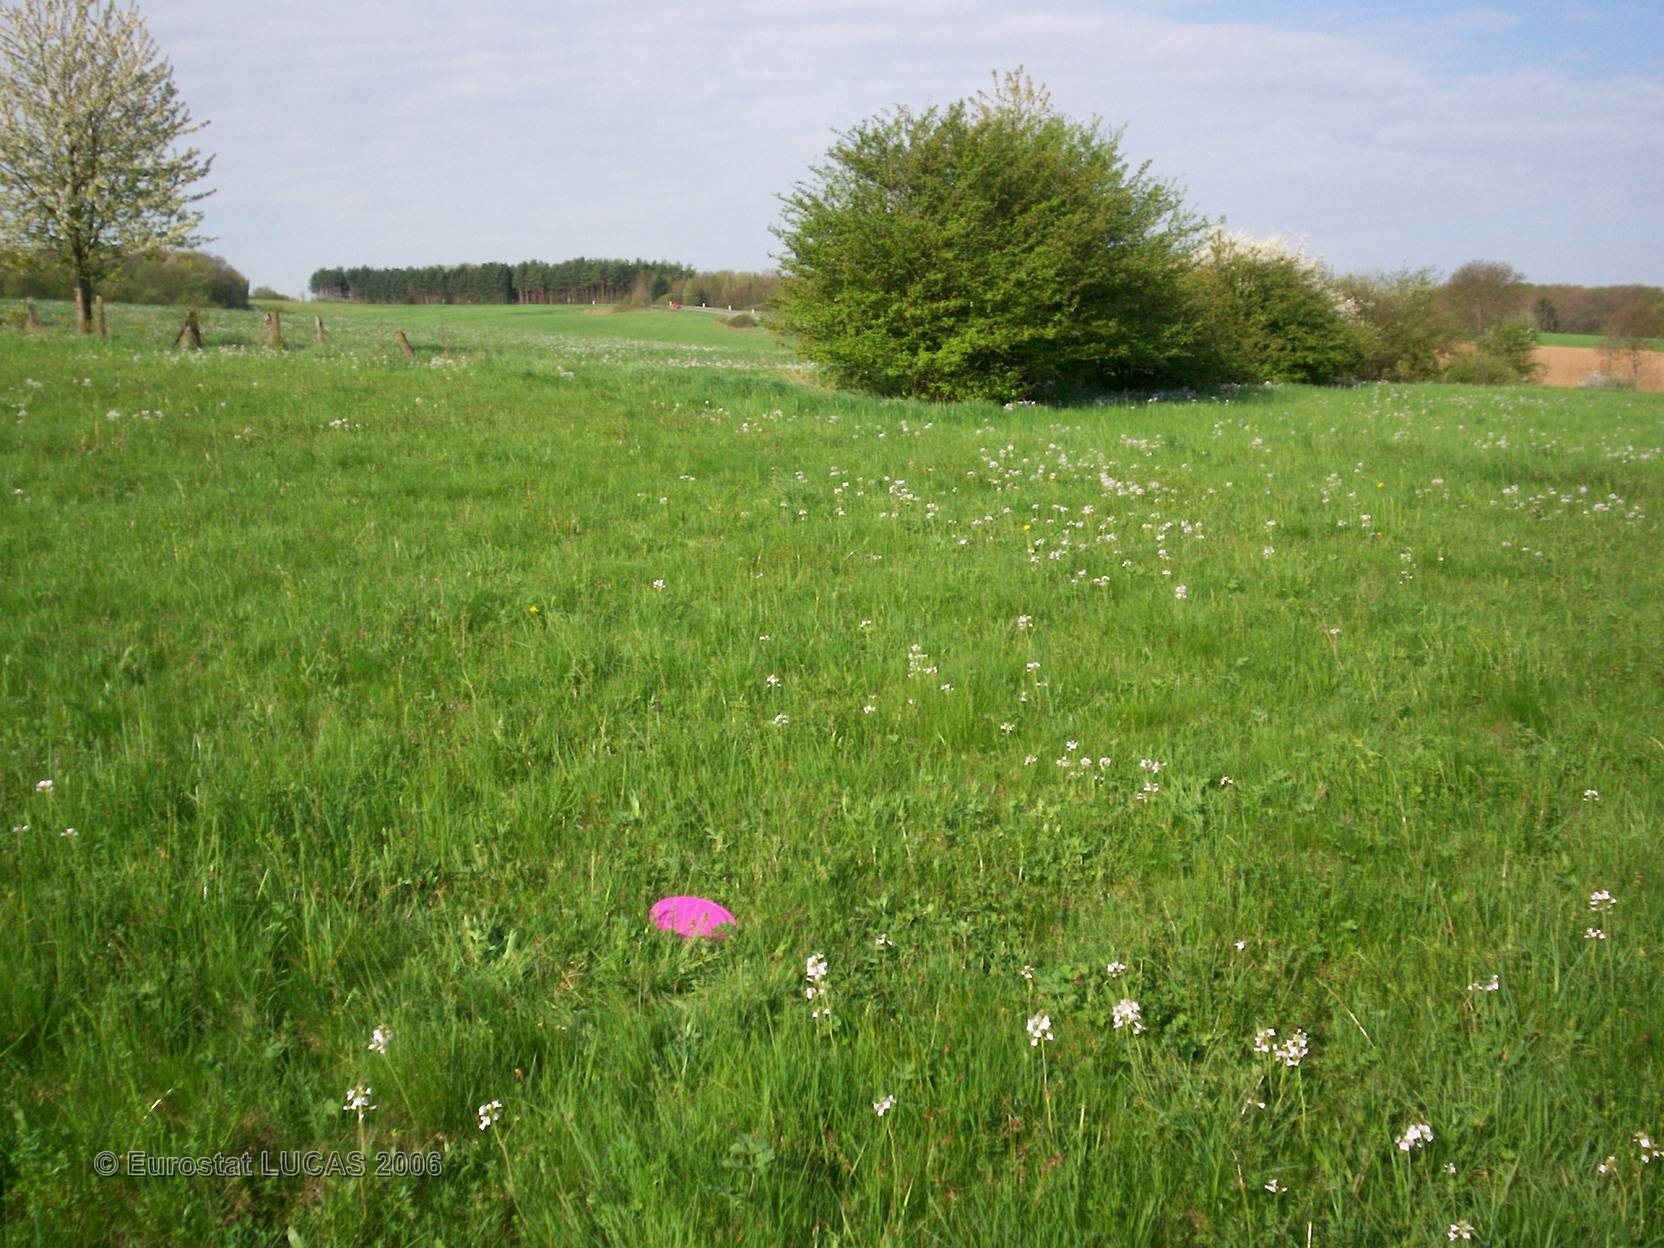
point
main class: Grassland
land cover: Grassland without tree/shrub cover
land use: Agriculture (excluding fallow land and kitchen gardens)
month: April
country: FR
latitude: 49.0448
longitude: 6.9221
